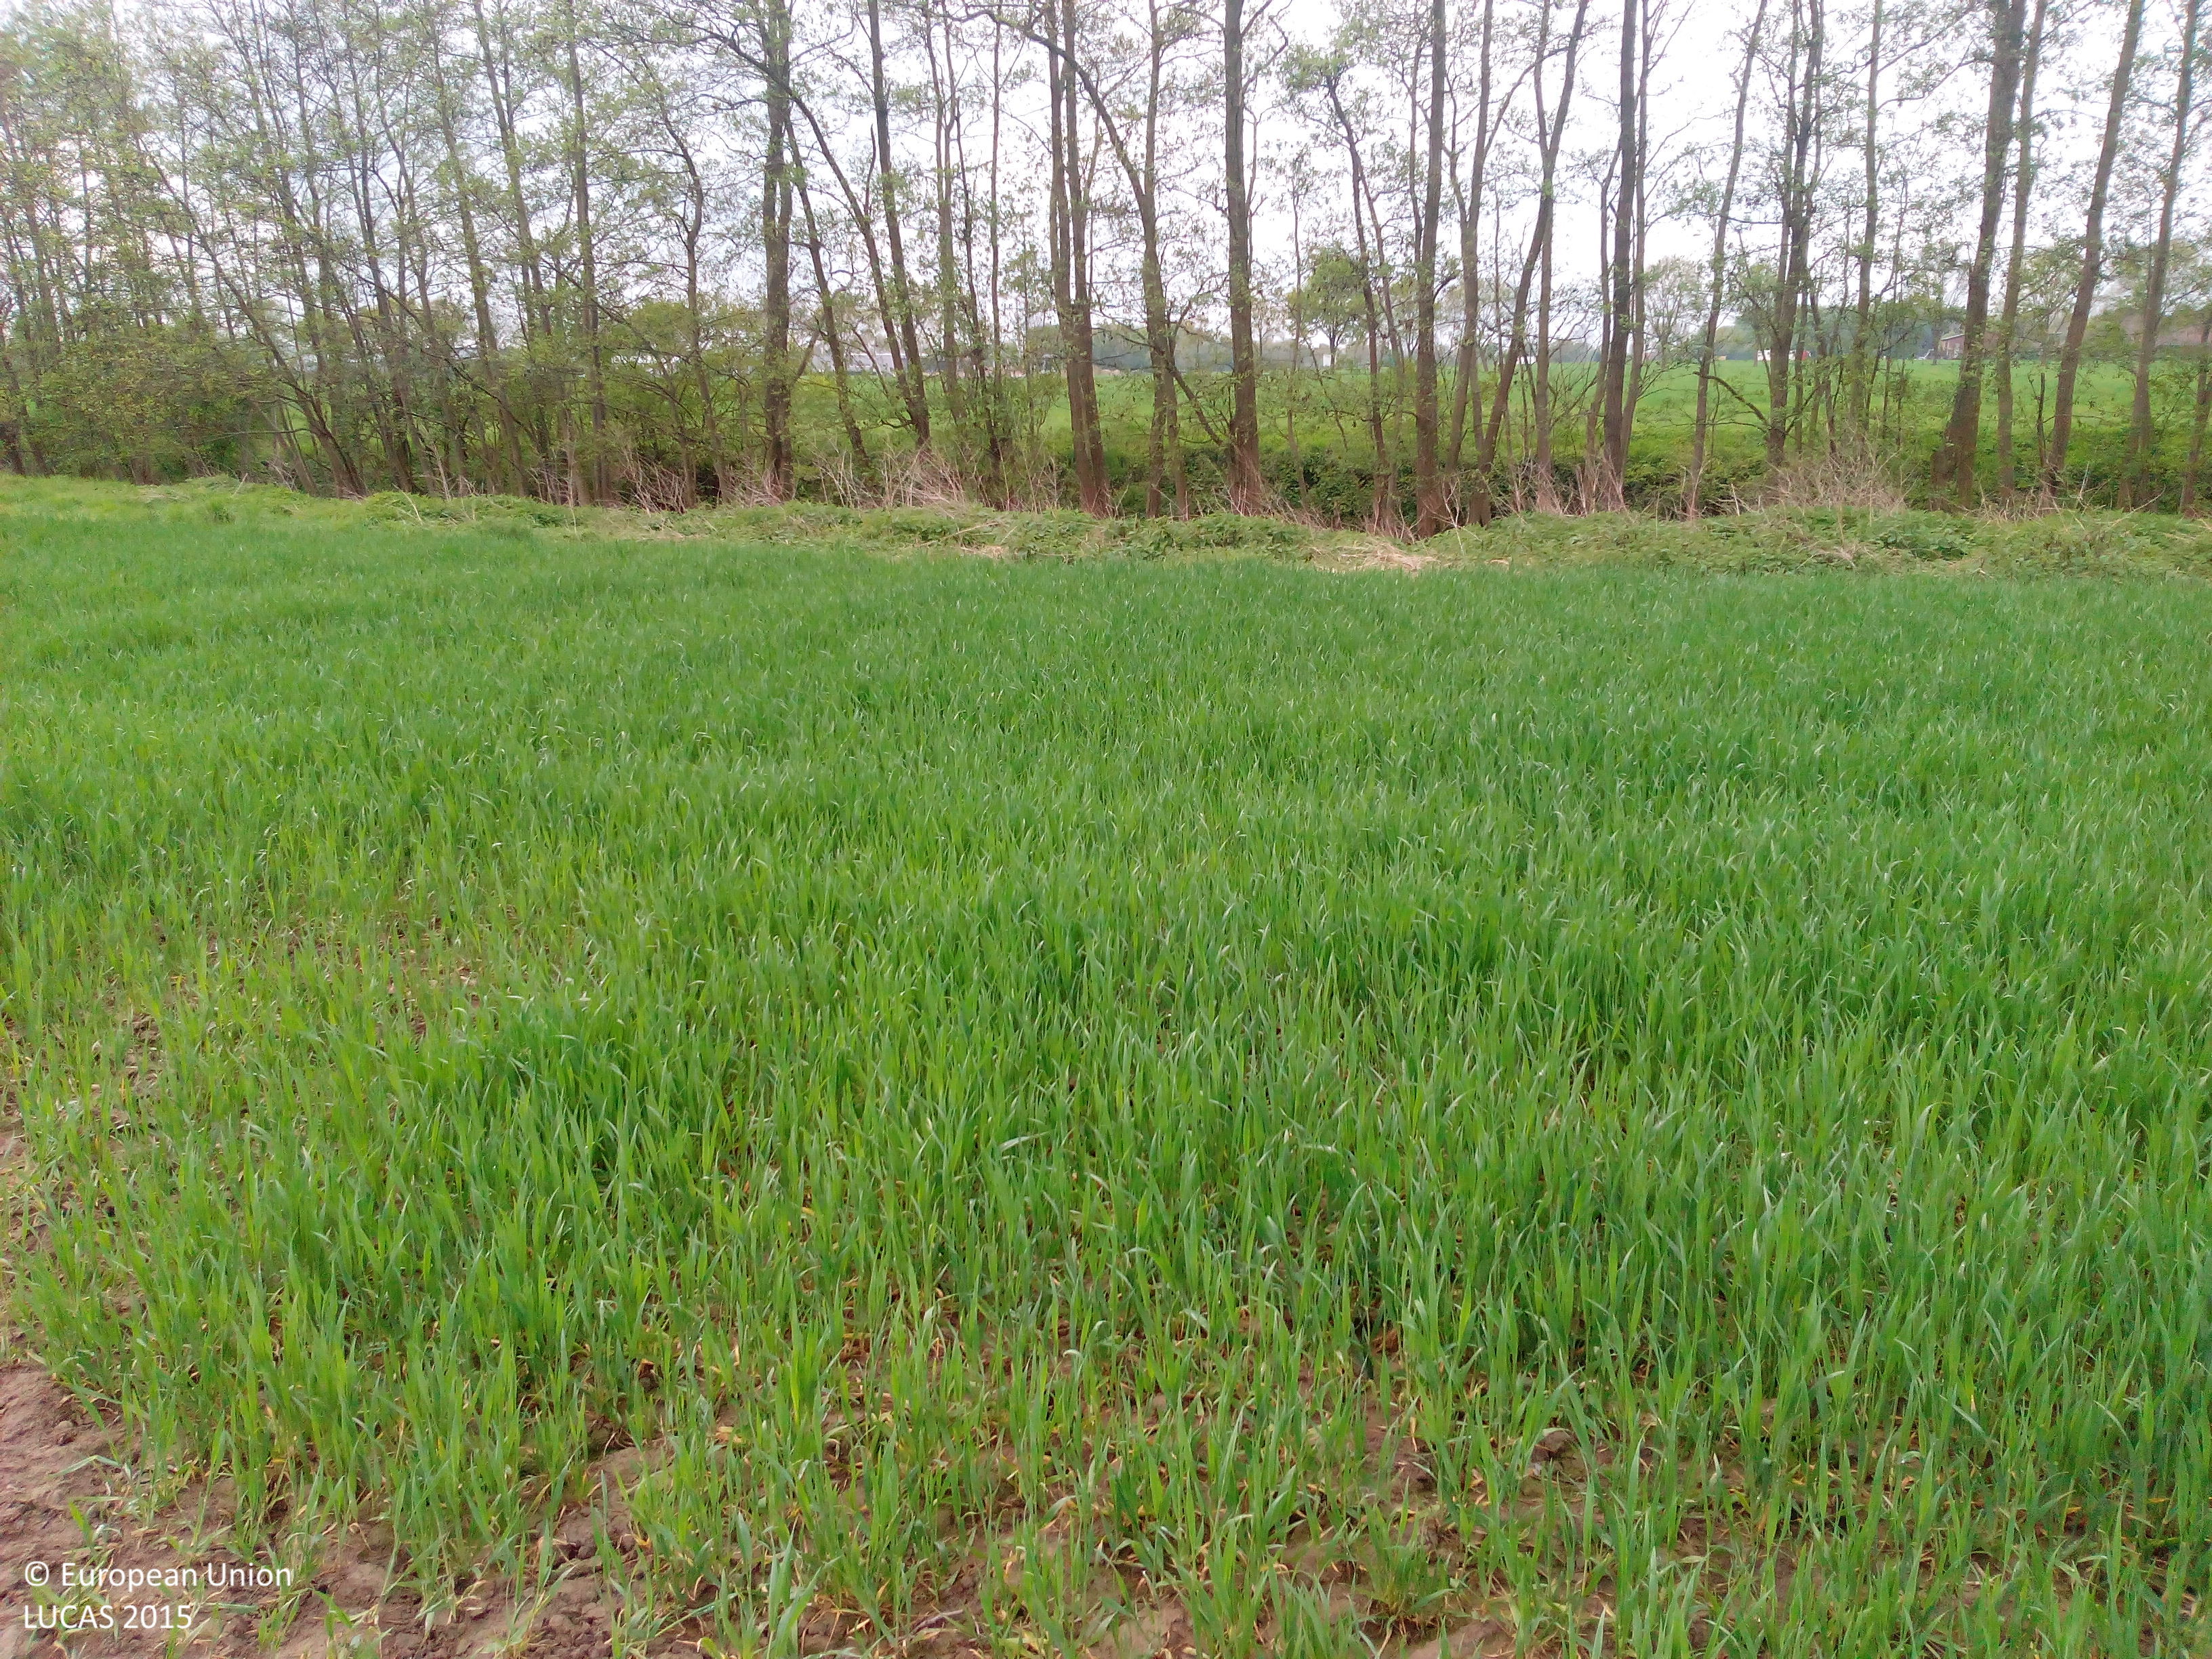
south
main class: Cropland
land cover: Common wheat
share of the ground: > 75 %
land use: Agriculture (excluding fallow land and kitchen gardens)
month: May
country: DE
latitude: 51.9174
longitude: 7.3978
